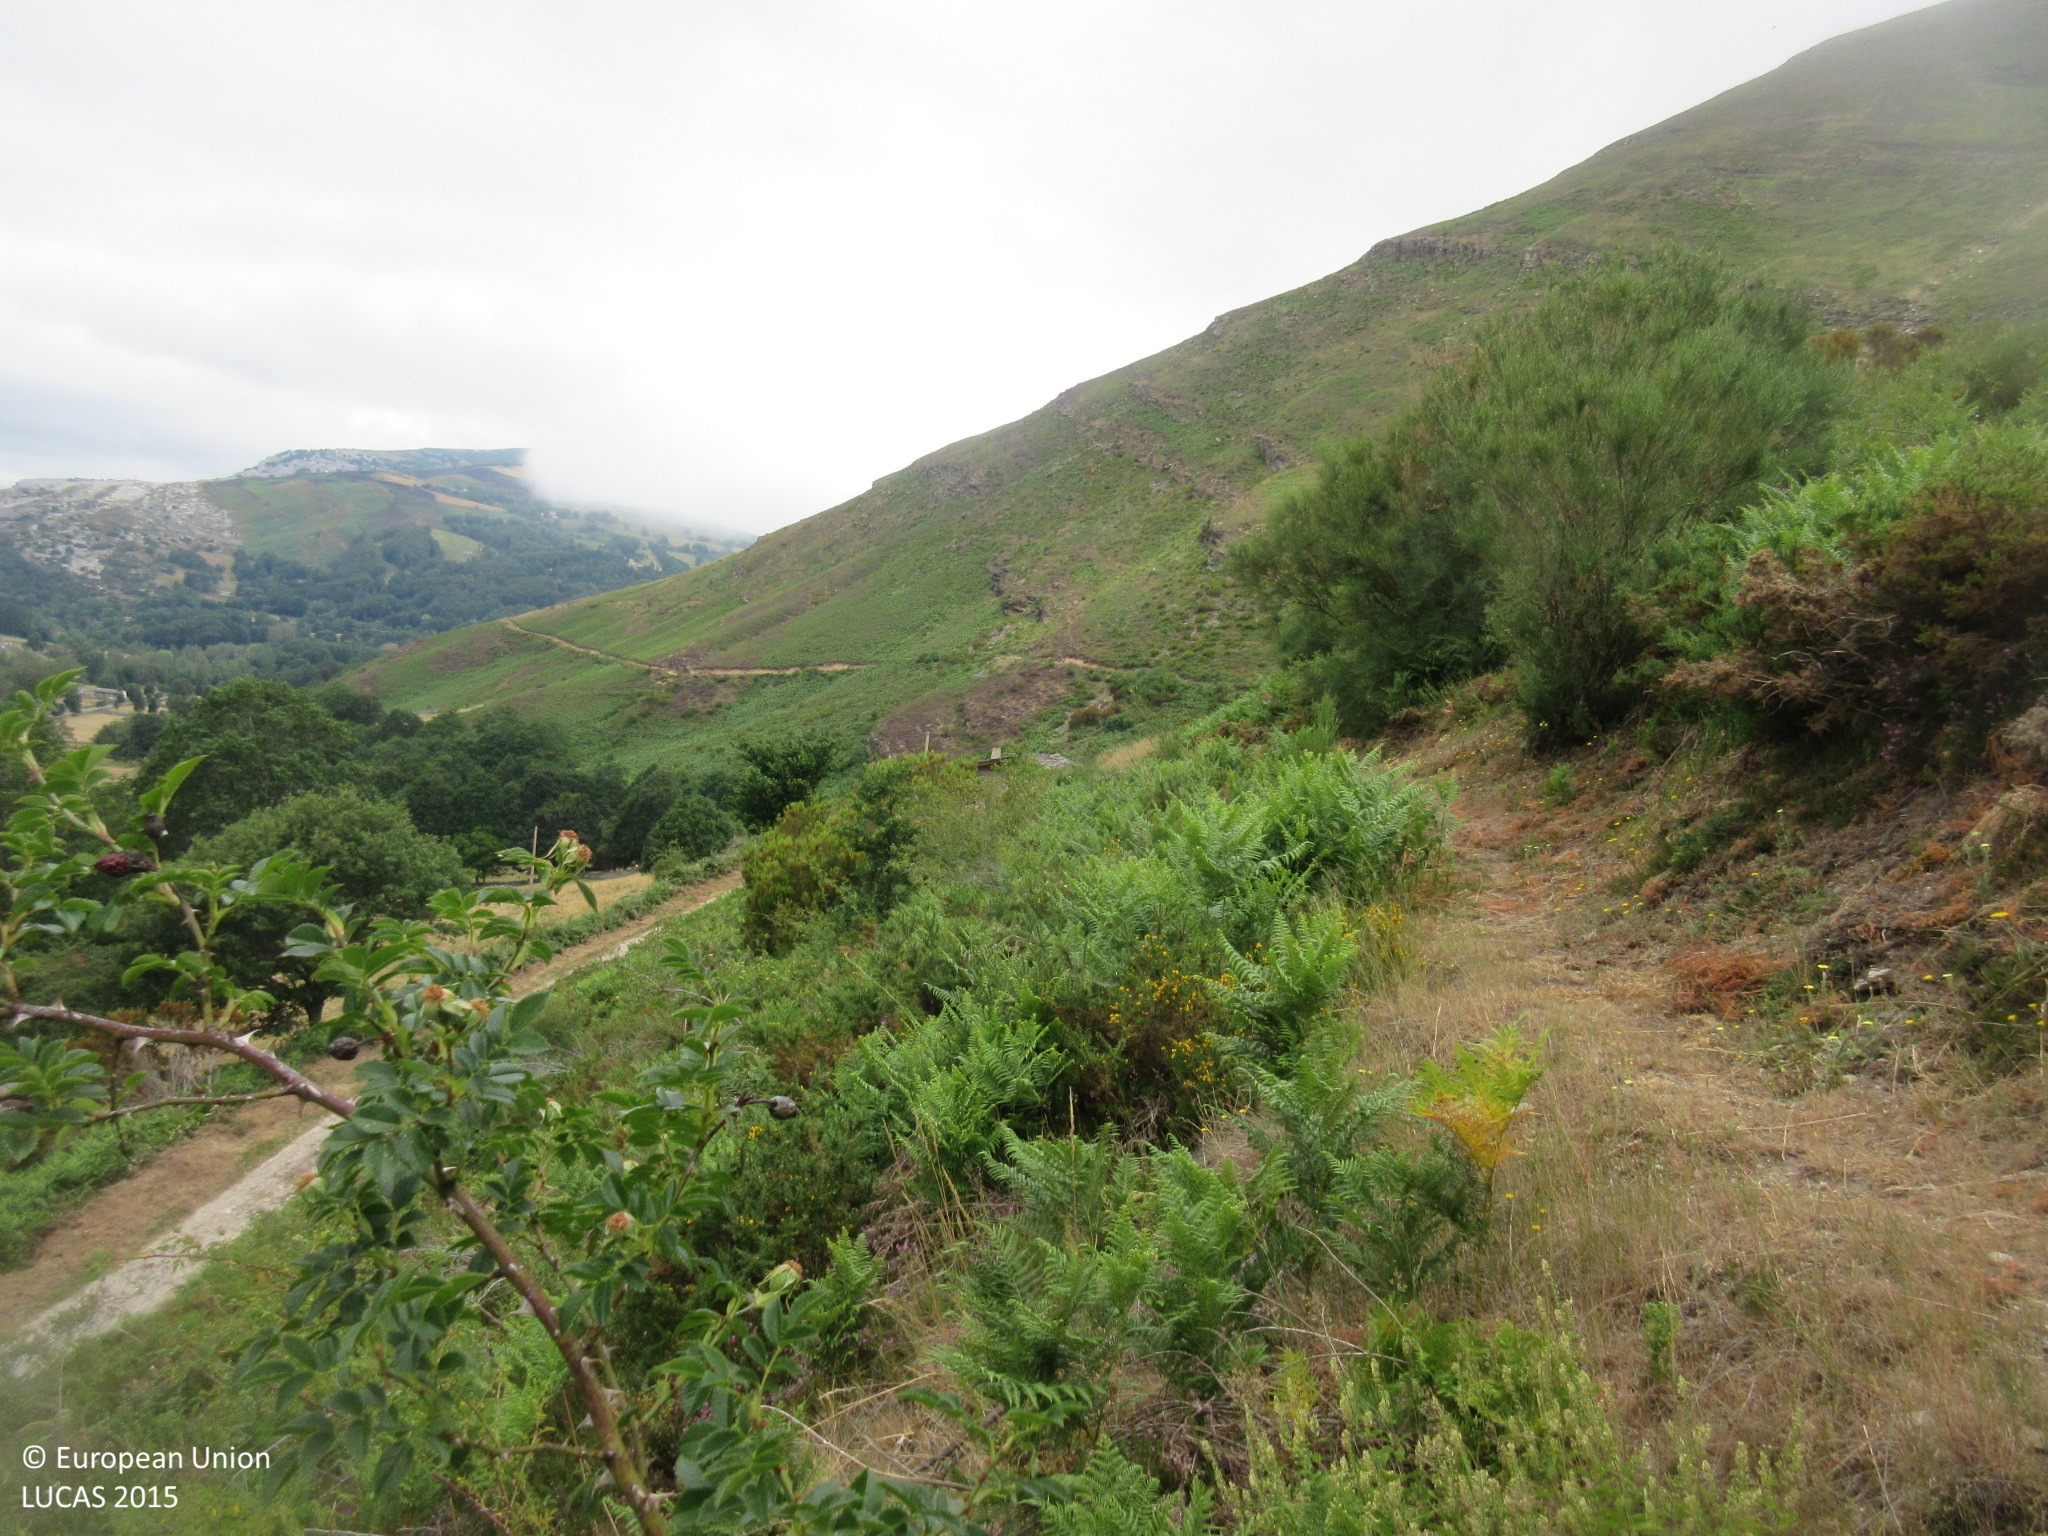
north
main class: Shrubland
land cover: Shrubland without tree cover
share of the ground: > 75 %
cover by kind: shrubs 100 %
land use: Semi-natural and natural areas not in use
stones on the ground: < 10 %
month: July
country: ES
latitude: 43.1071
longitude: -3.5712
